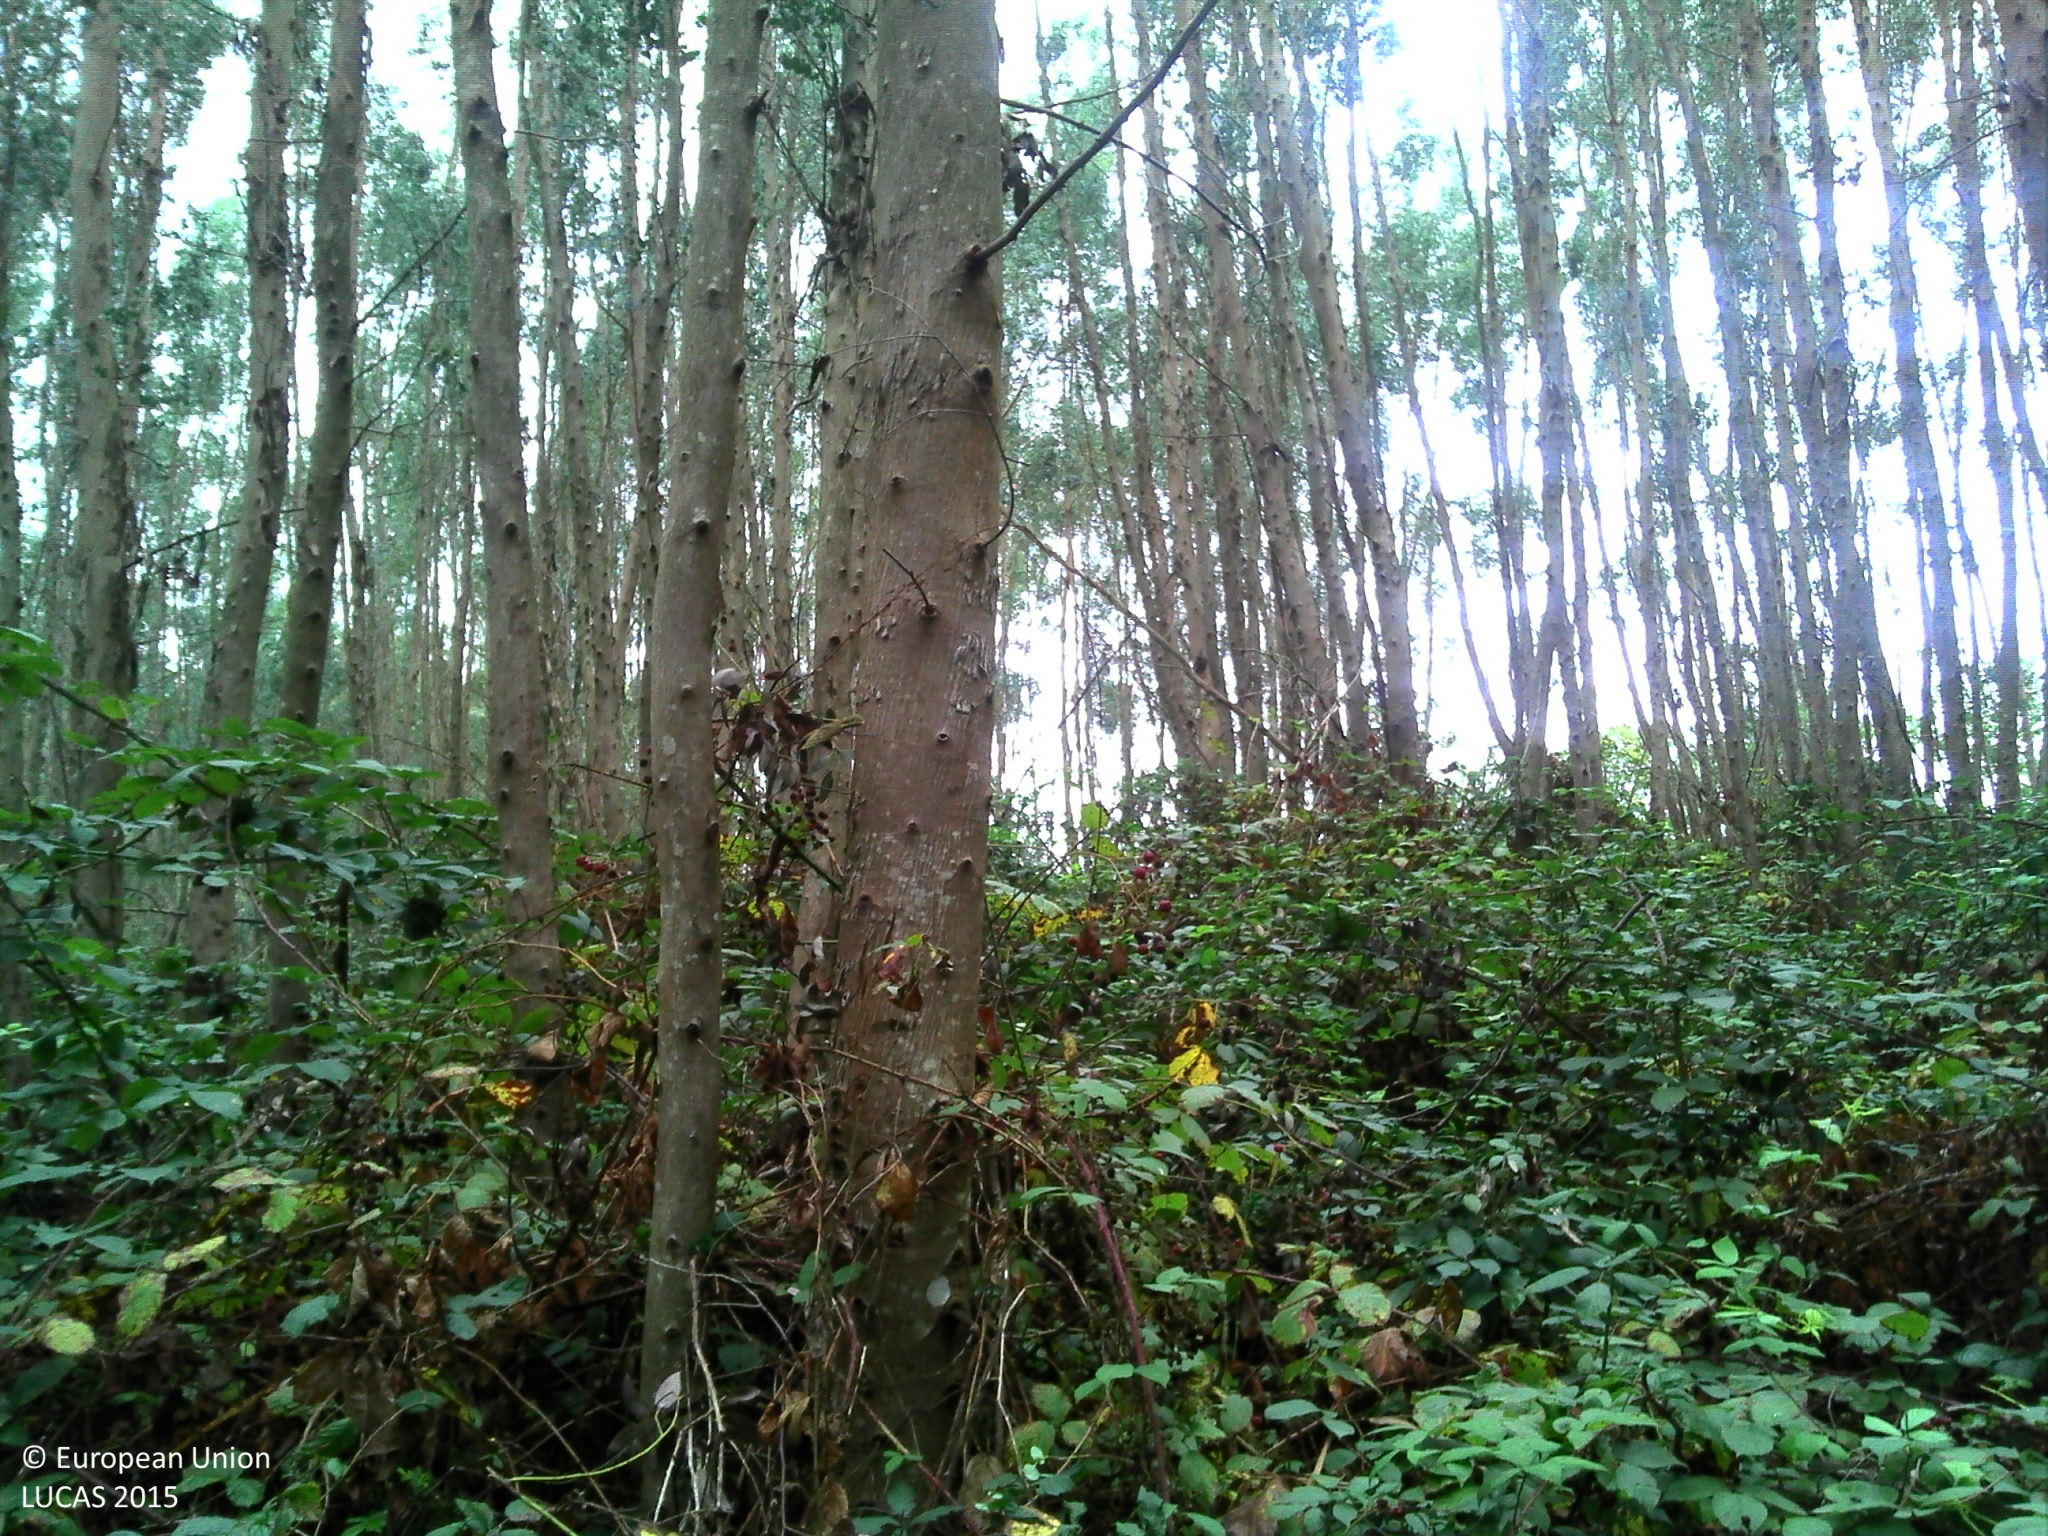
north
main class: Woodland
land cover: Broadleaved woodland
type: exotic forest
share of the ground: 50 - 75 %
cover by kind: broadleaved forest trees 60 %, shrubs 30 %, herbaceous plants 5 %, lichens and mosses 5 %
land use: Forestry
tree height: > 5 m
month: September
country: FR
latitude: 43.3813
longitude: -0.4878
